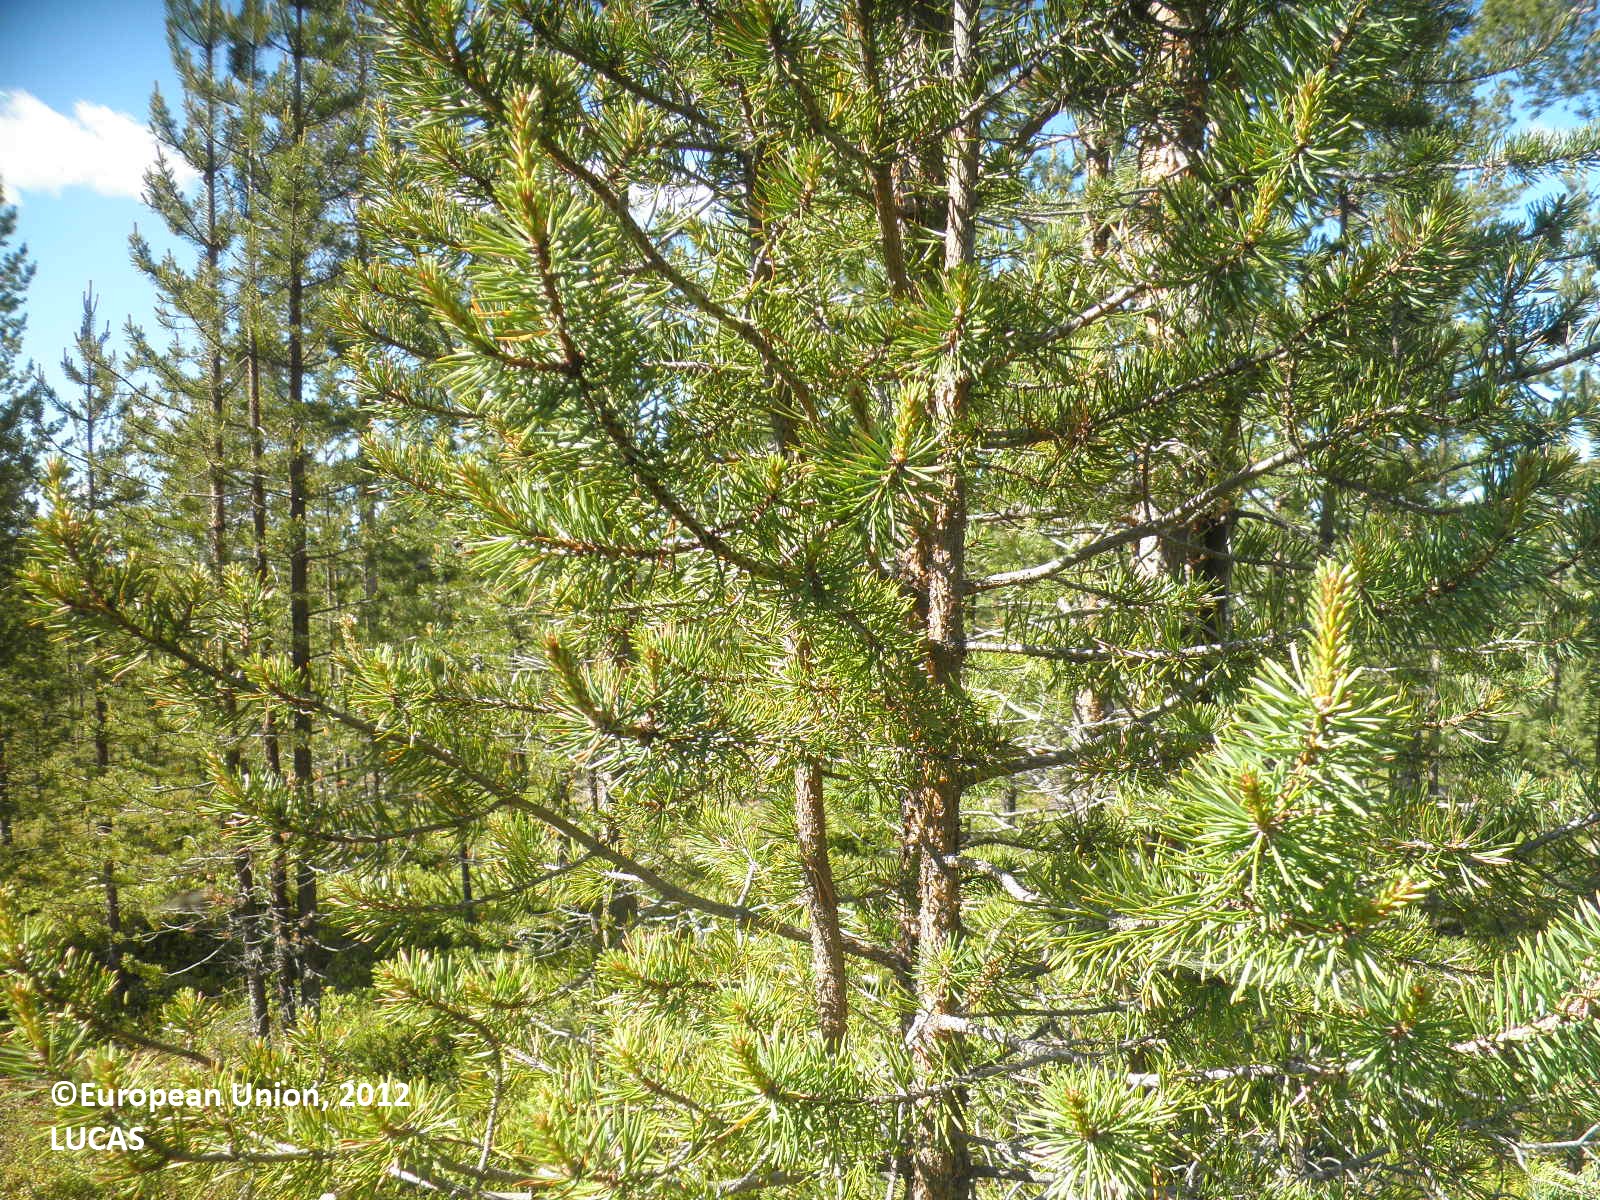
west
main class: Woodland
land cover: Pine dominated coniferous woodland
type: boreal forest
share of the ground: 25 - 50 %
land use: Forestry
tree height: > 5 m
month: July
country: FI
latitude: 68.7972
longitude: 26.8302
